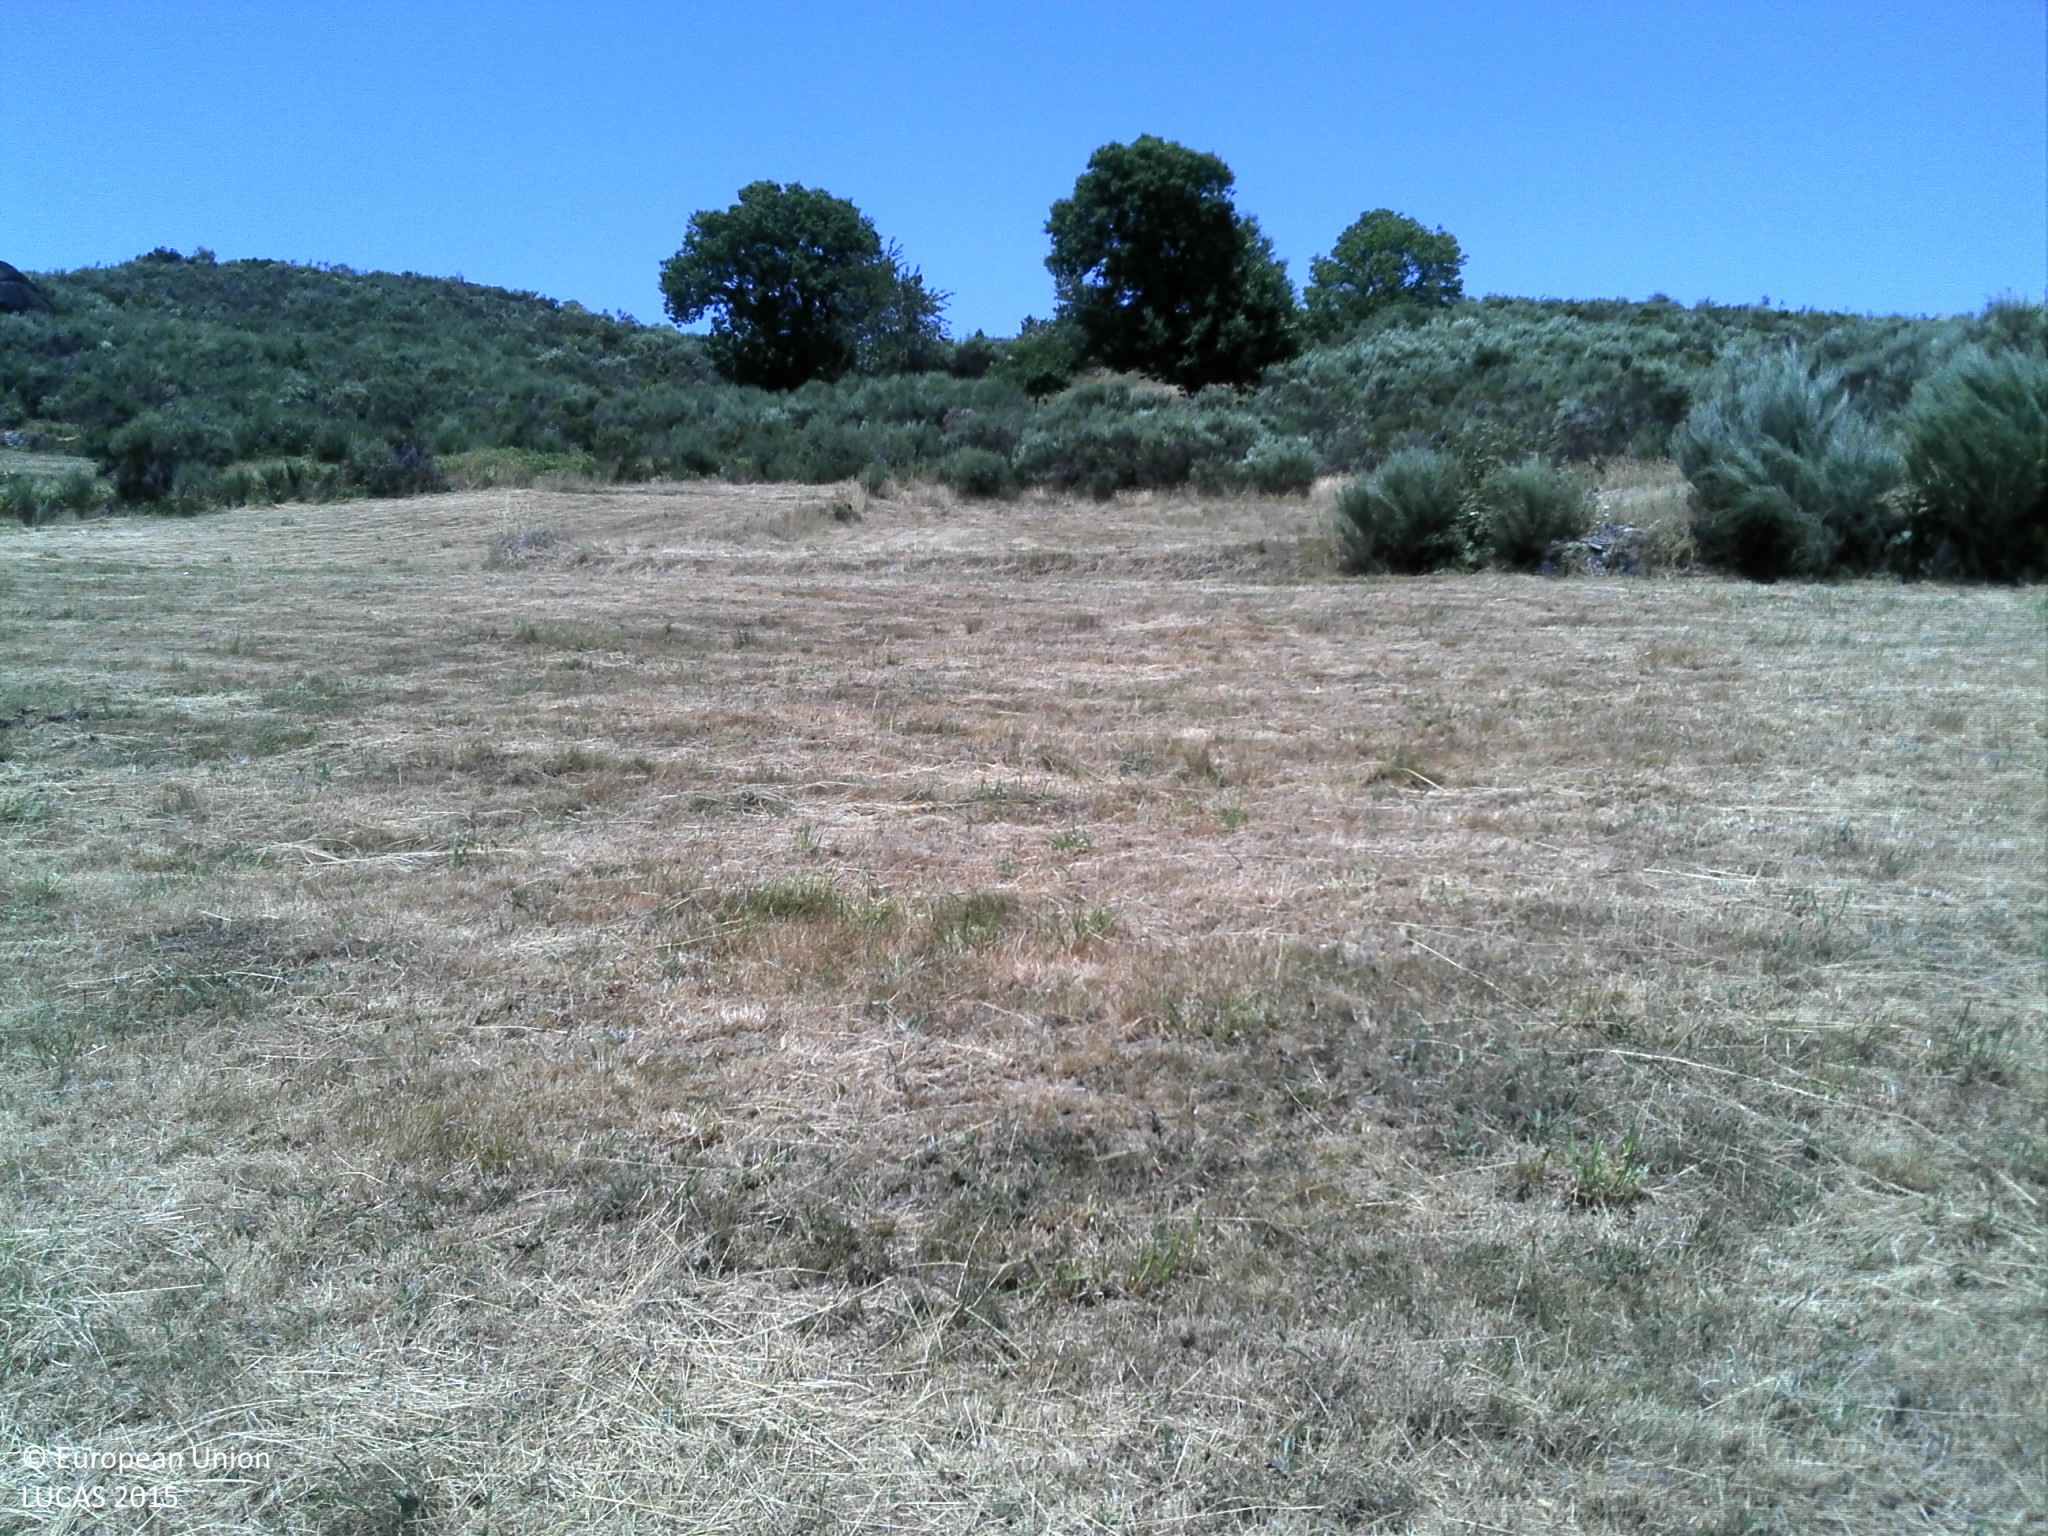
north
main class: Grassland
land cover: Grassland without tree/shrub cover
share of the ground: > 75 %
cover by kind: herbaceous plants 75 %, unconsolidated bare surface 25 %
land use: Agriculture (excluding fallow land and kitchen gardens)
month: July
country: PT
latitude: 40.9754
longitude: -7.8716
